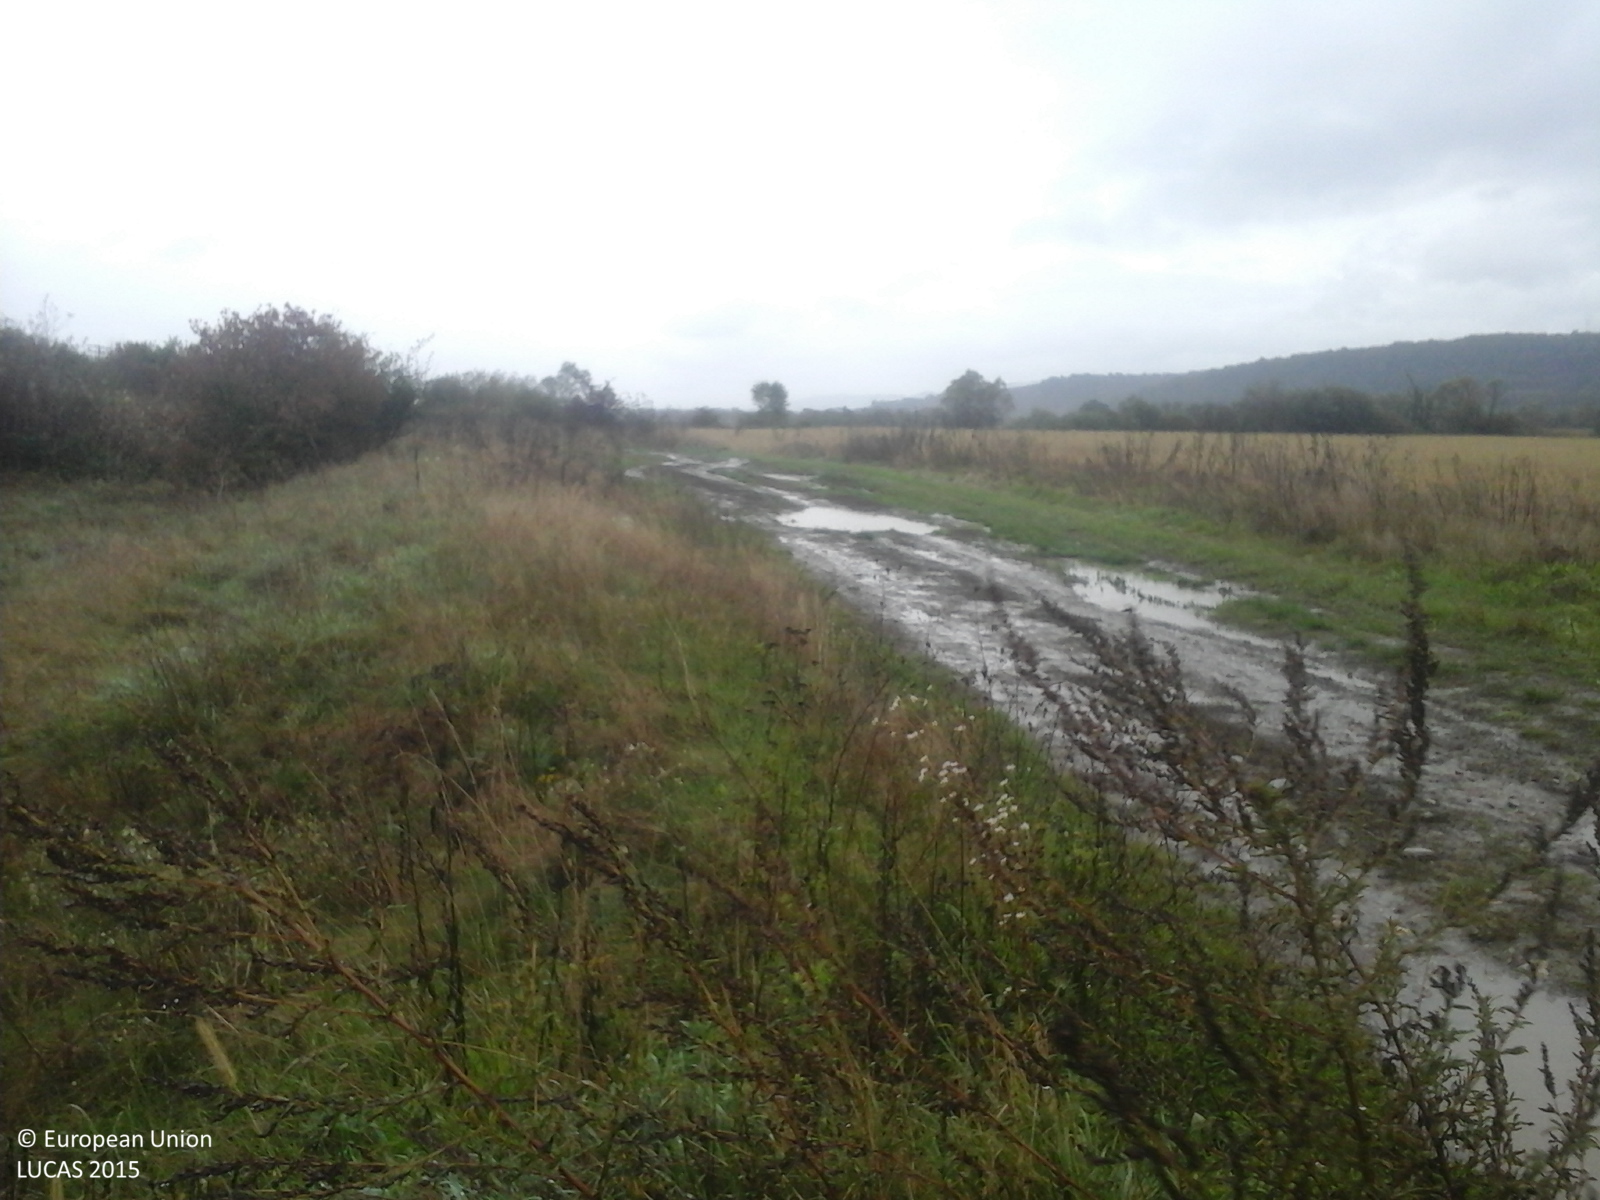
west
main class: Grassland
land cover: Spontaneously vegetated surfaces
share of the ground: > 75 %
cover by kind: herbaceous plants 100 %
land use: Fallow land
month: October
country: RO
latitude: 45.7917
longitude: 24.6601
